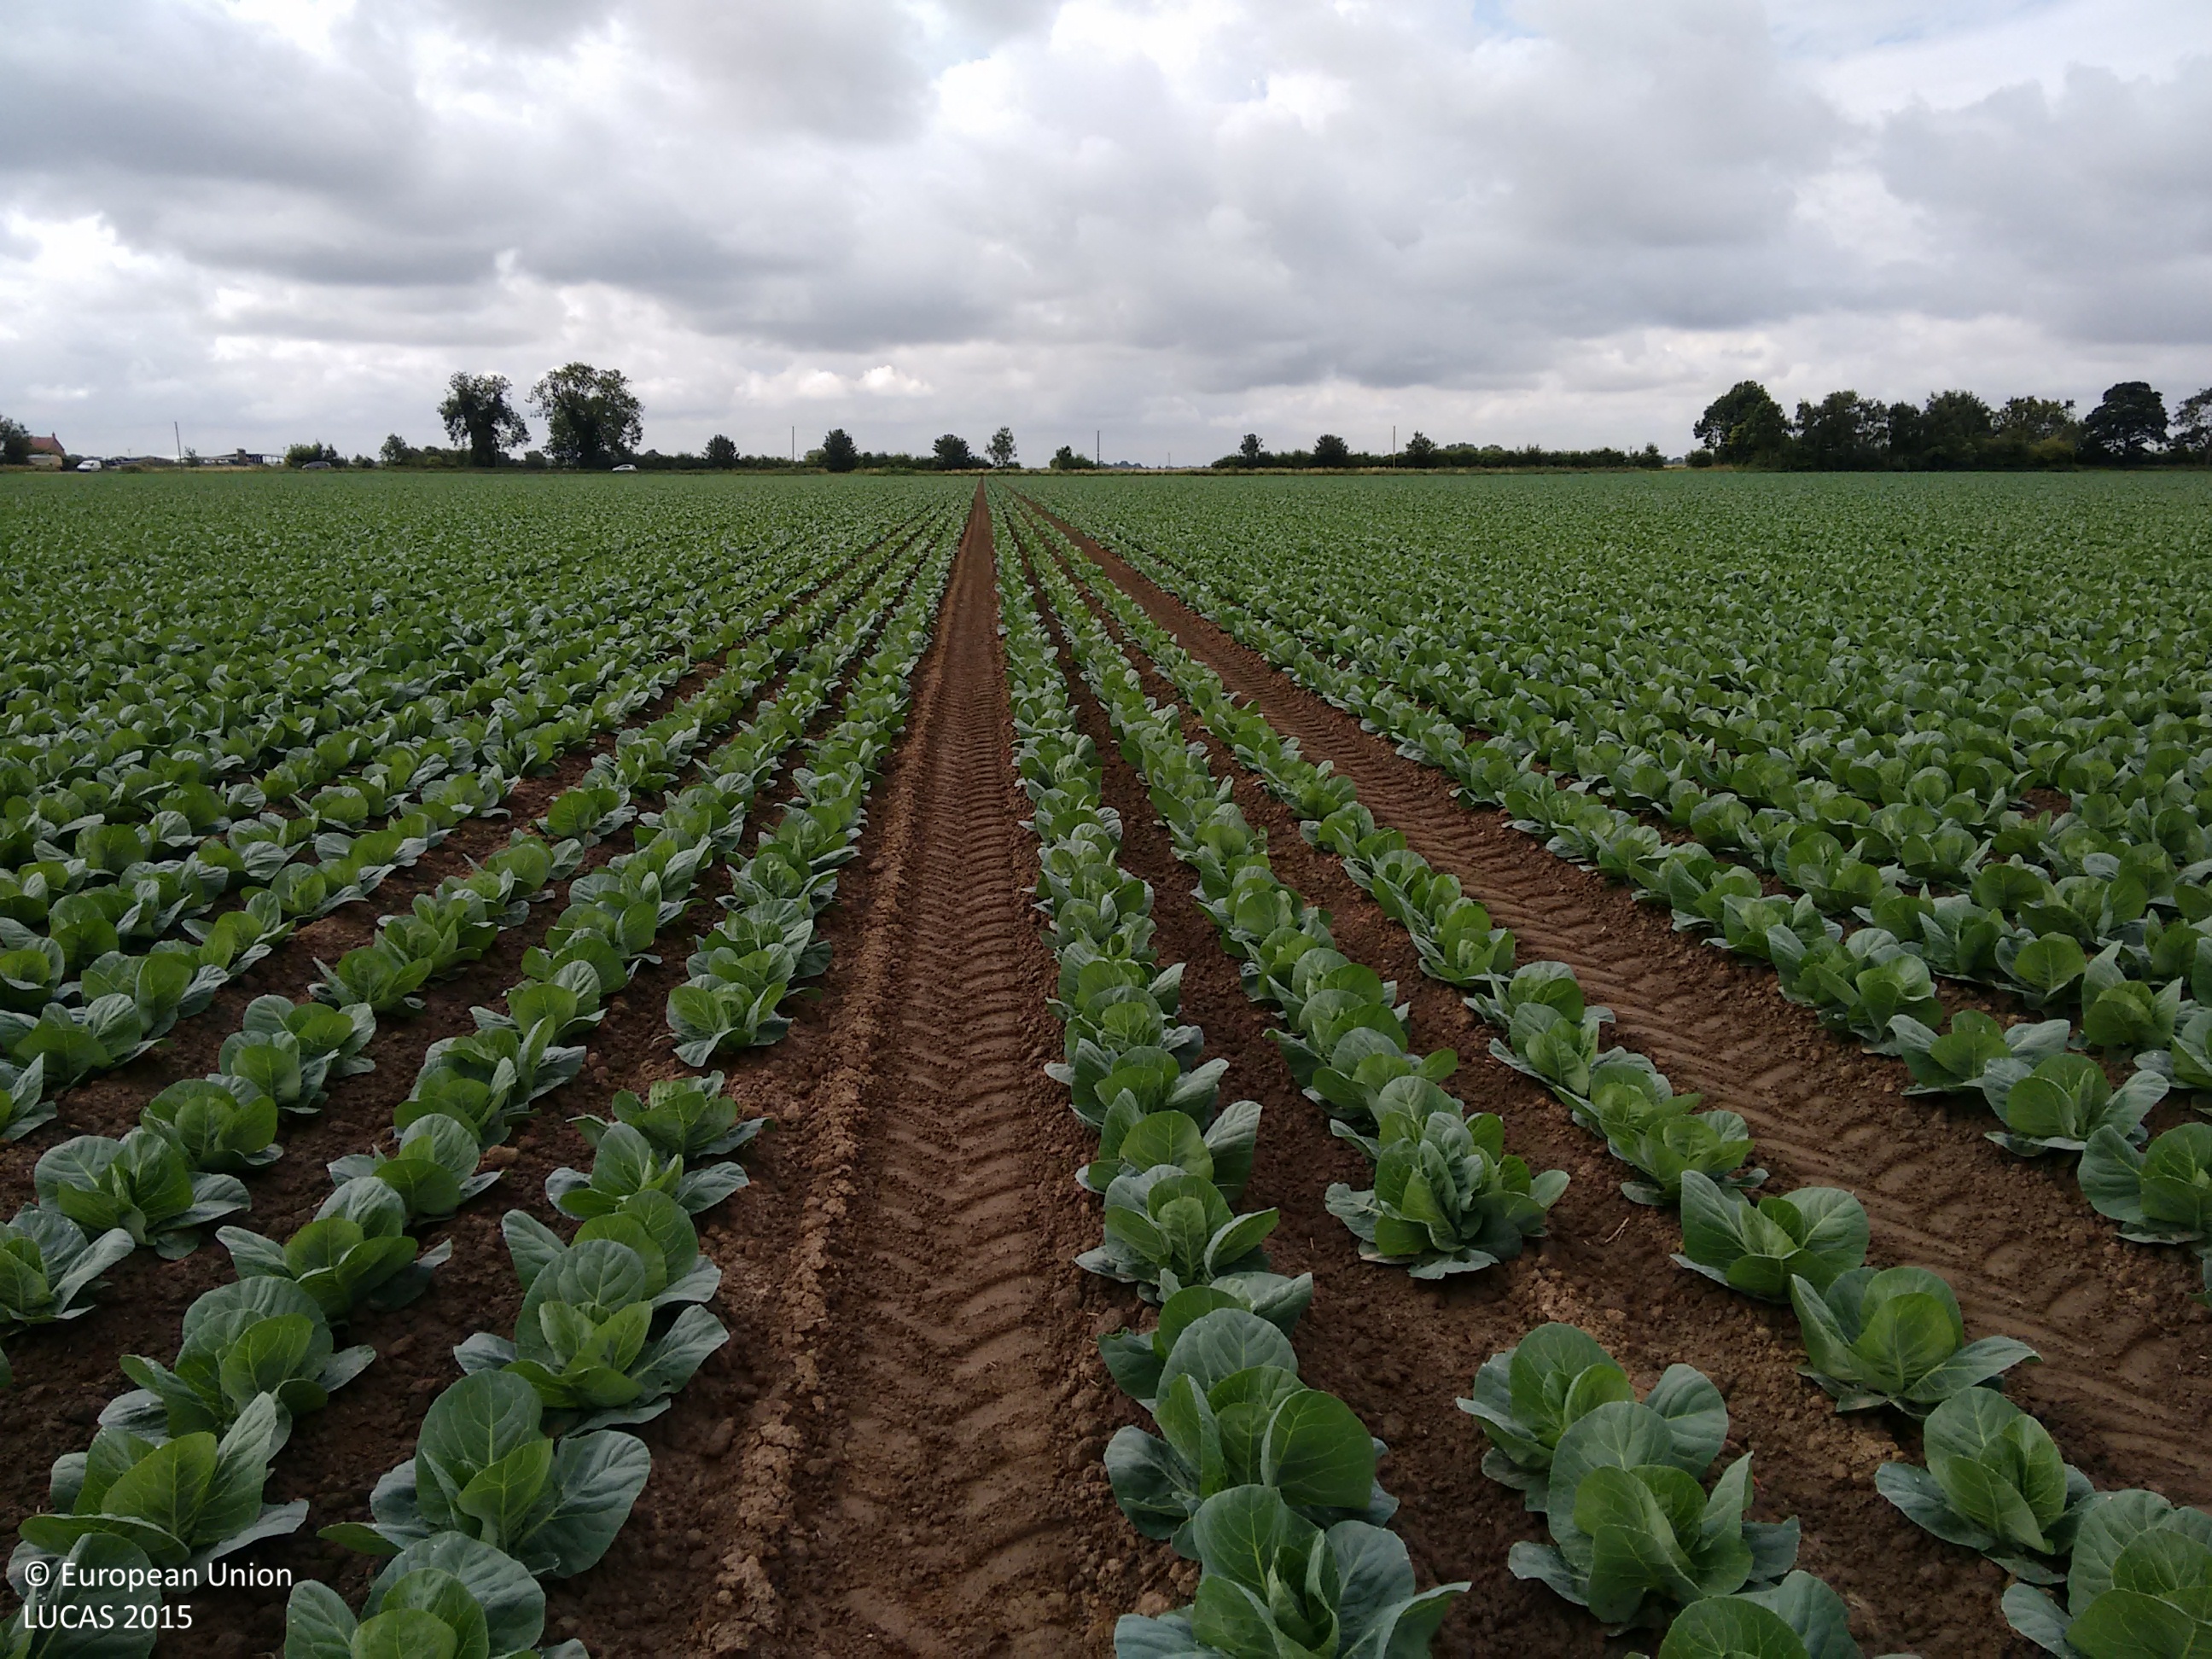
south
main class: Cropland
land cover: Other fresh vegetables
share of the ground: 50 - 75 %
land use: Agriculture (excluding fallow land and kitchen gardens)
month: July
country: GB
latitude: 52.9975
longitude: -0.0905
